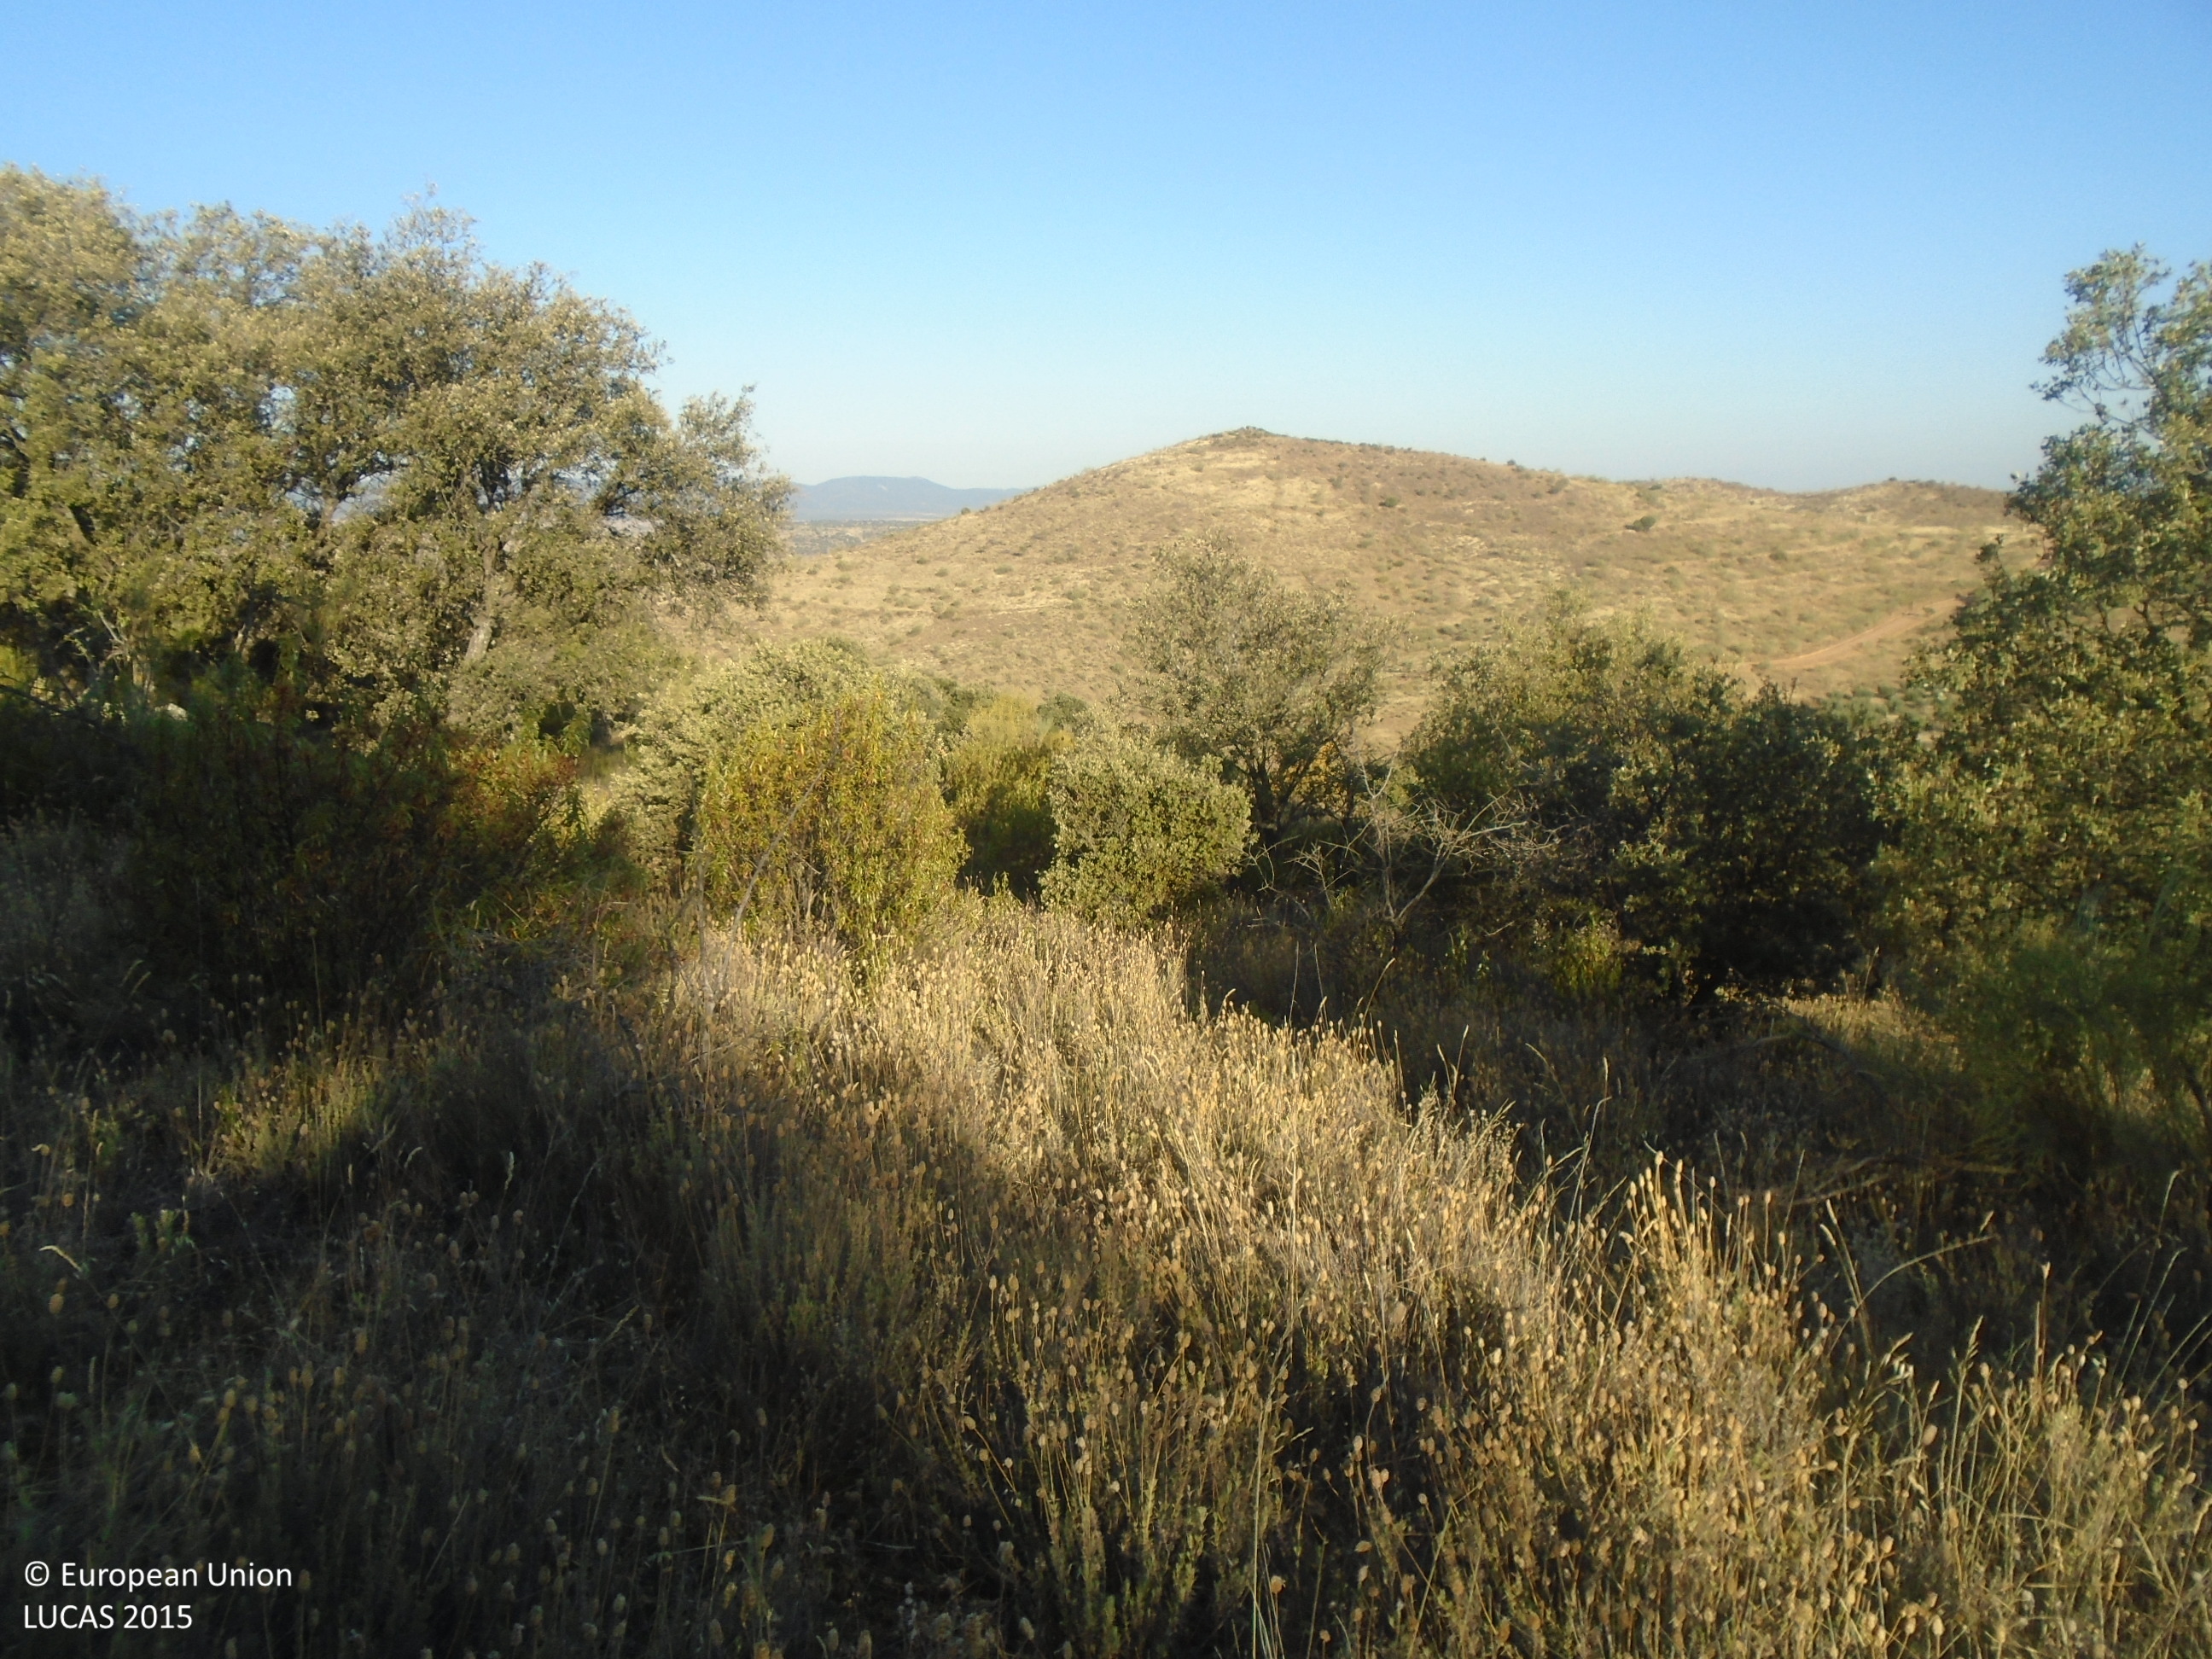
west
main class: Shrubland
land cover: Shrubland with sparse tree cover
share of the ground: > 75 %
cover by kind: shrubs 85 %, herbaceous plants 10 %, broadleaved forest trees 5 %
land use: Semi-natural and natural areas not in use
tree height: < 5 m
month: July
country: ES
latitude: 39.7003
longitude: -5.0809
